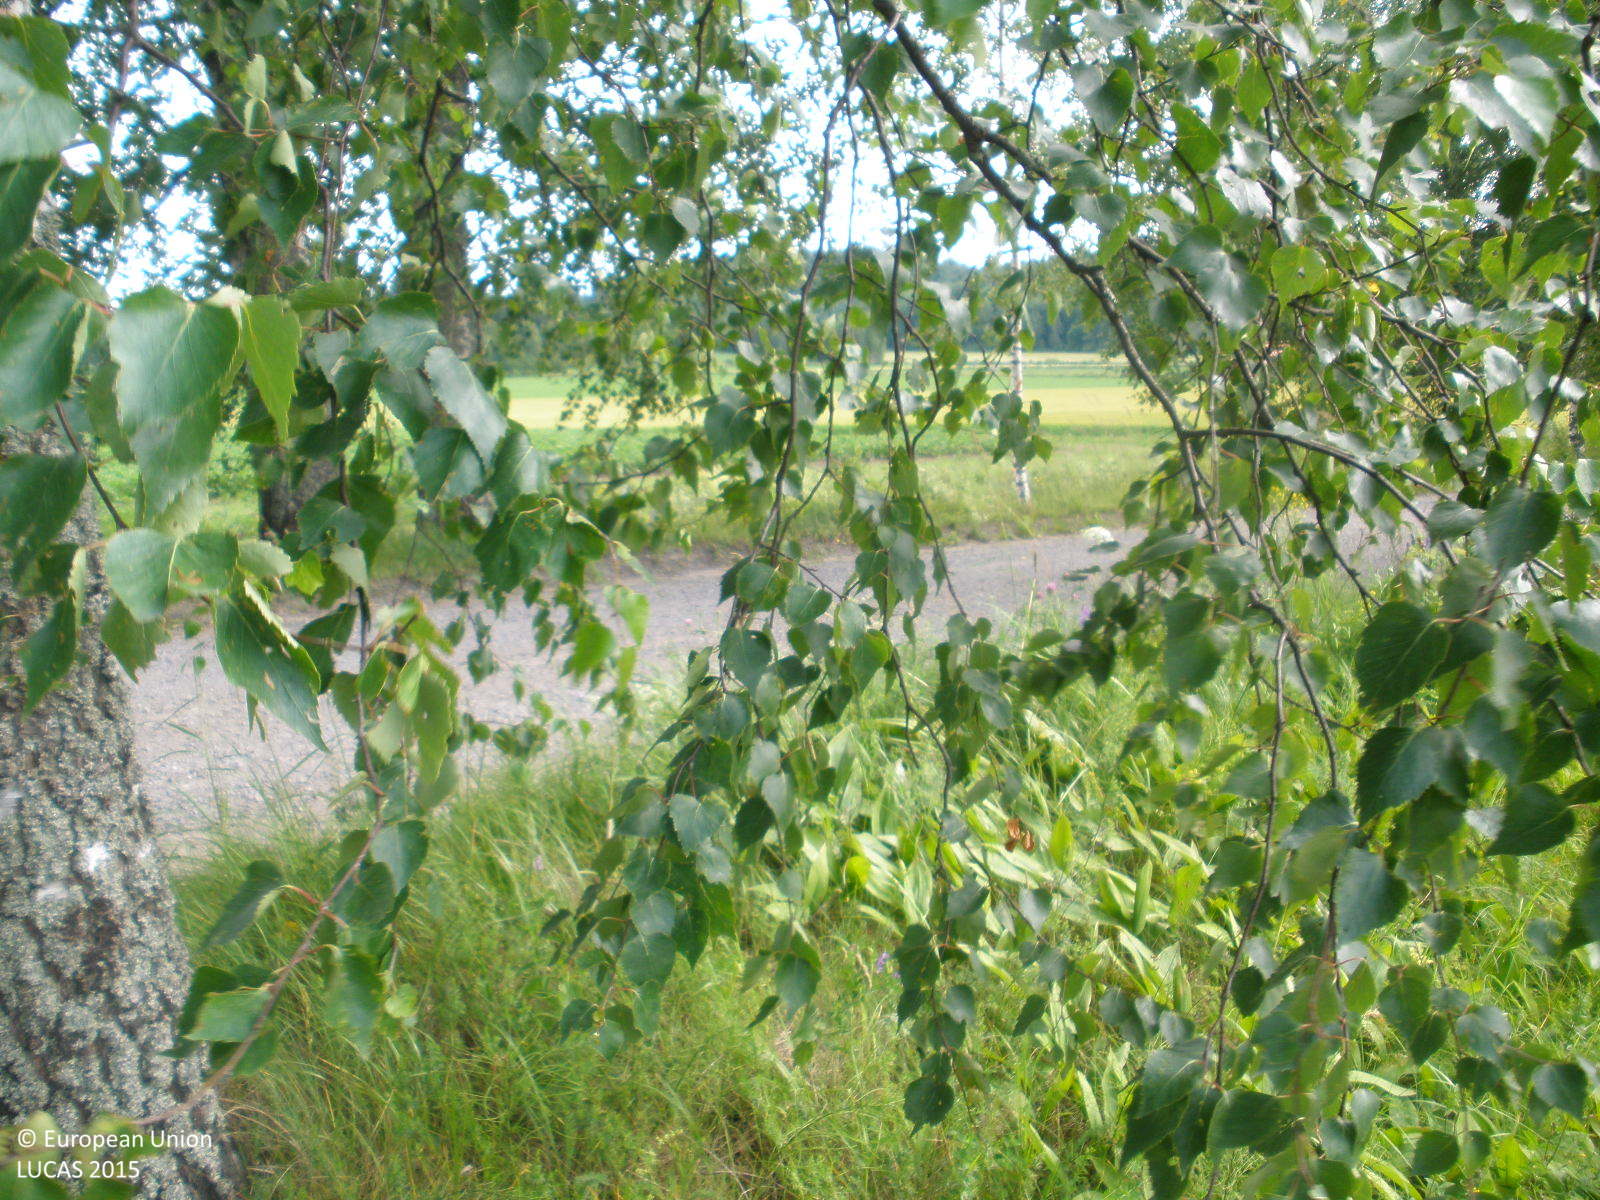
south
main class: Cropland
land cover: Rape and turnip rape
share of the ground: > 75 %
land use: Agriculture (excluding fallow land and kitchen gardens)
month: July
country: FI
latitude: 61.0992
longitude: 25.0075
